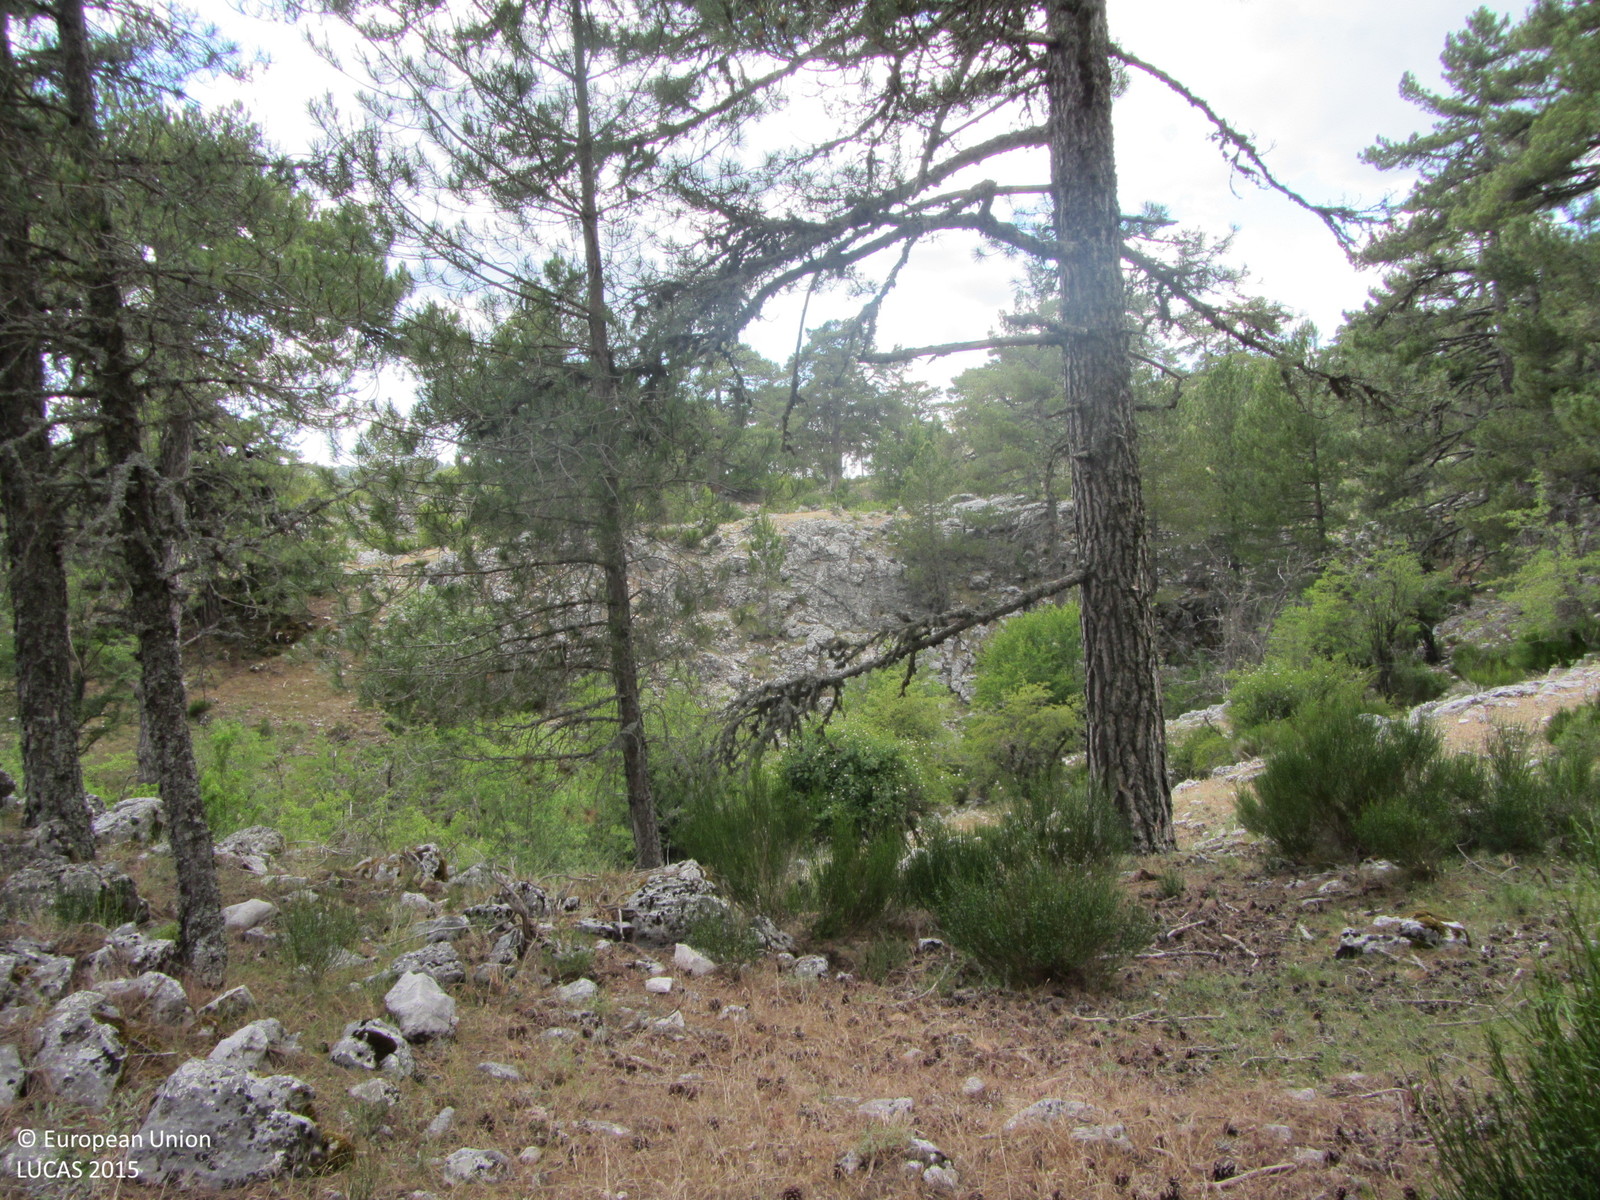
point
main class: Woodland
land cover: Pine dominated coniferous woodland
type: coniferous forest of the mediterranean region
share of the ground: 50 - 75 %
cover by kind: coniferous forest trees 70 %, shrubs 15 %, herbaceous plants 15 %
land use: Forestry
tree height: > 5 m
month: June
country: ES
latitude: 37.9426
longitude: -2.7953
